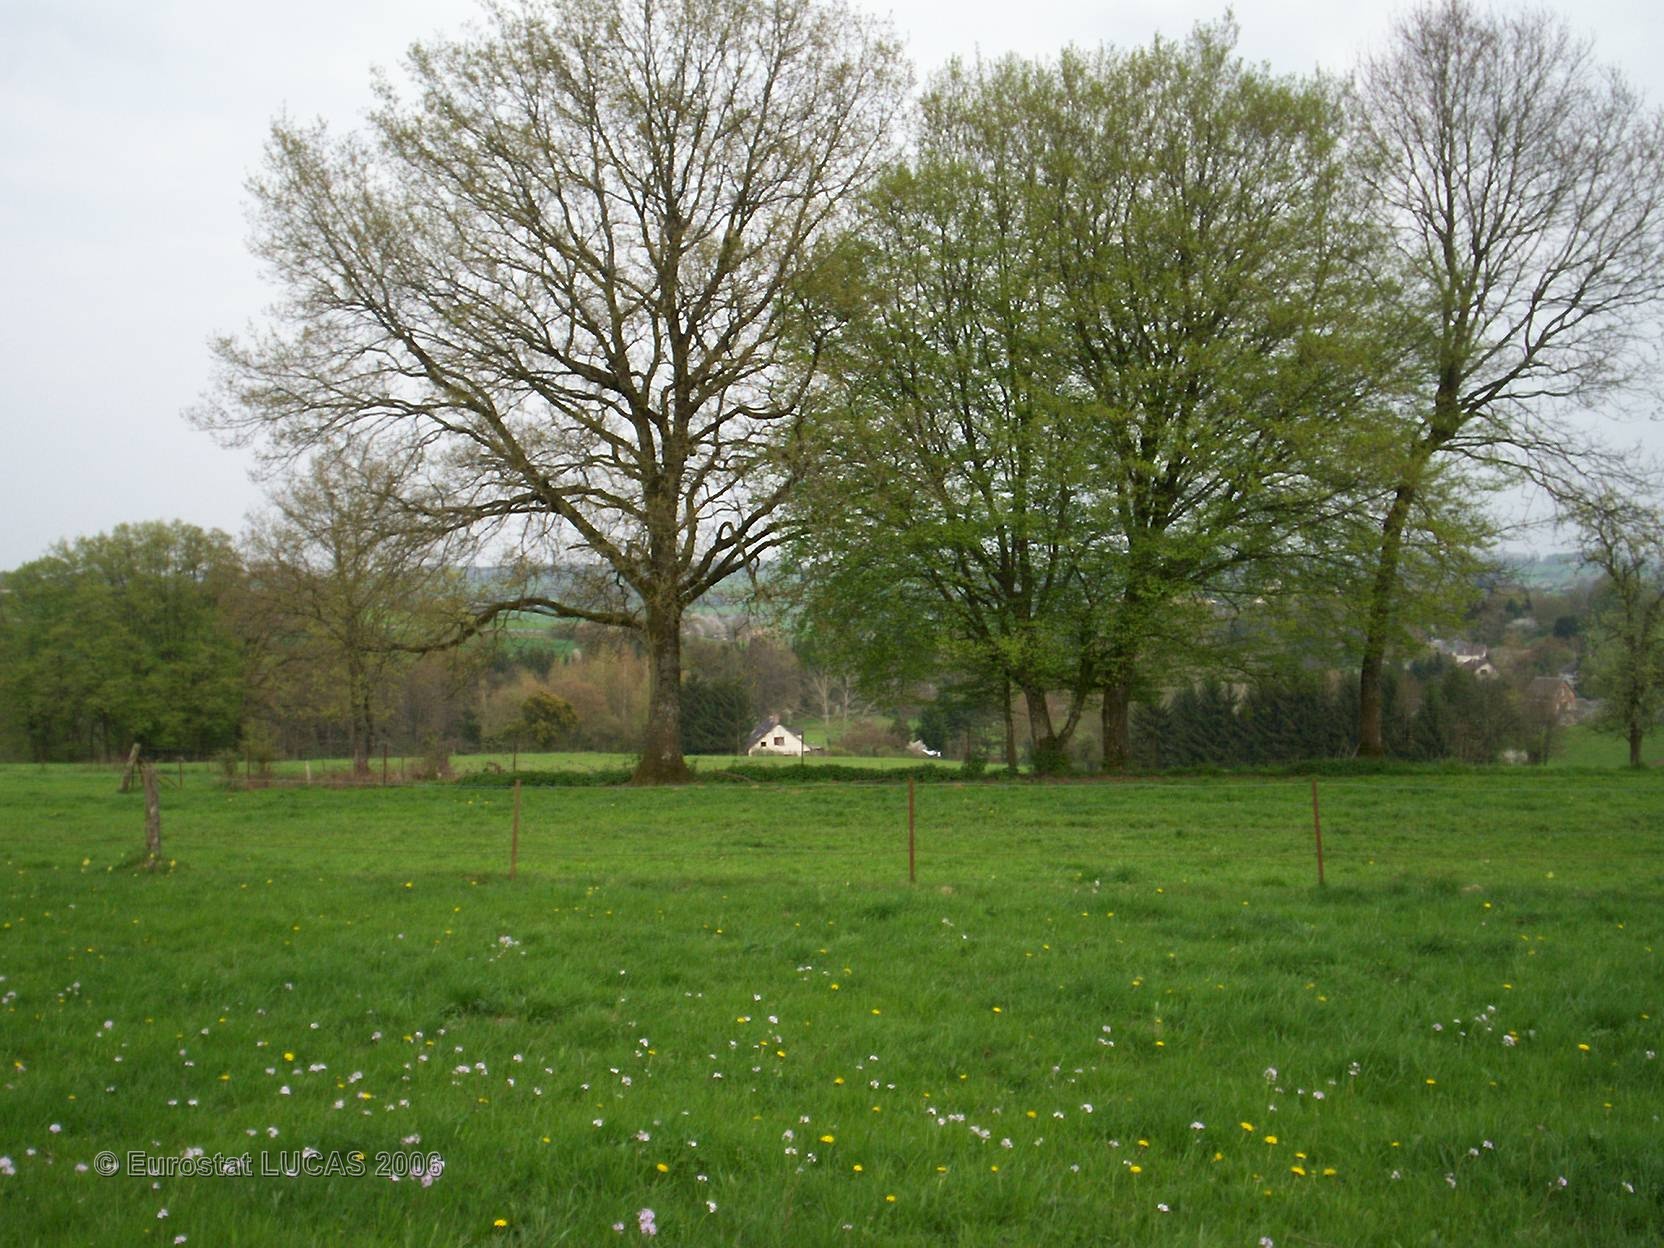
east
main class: Grassland
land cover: Grassland without tree/shrub cover
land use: Agriculture (excluding fallow land and kitchen gardens)
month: April
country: FR
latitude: 49.7045
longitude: 4.4079
